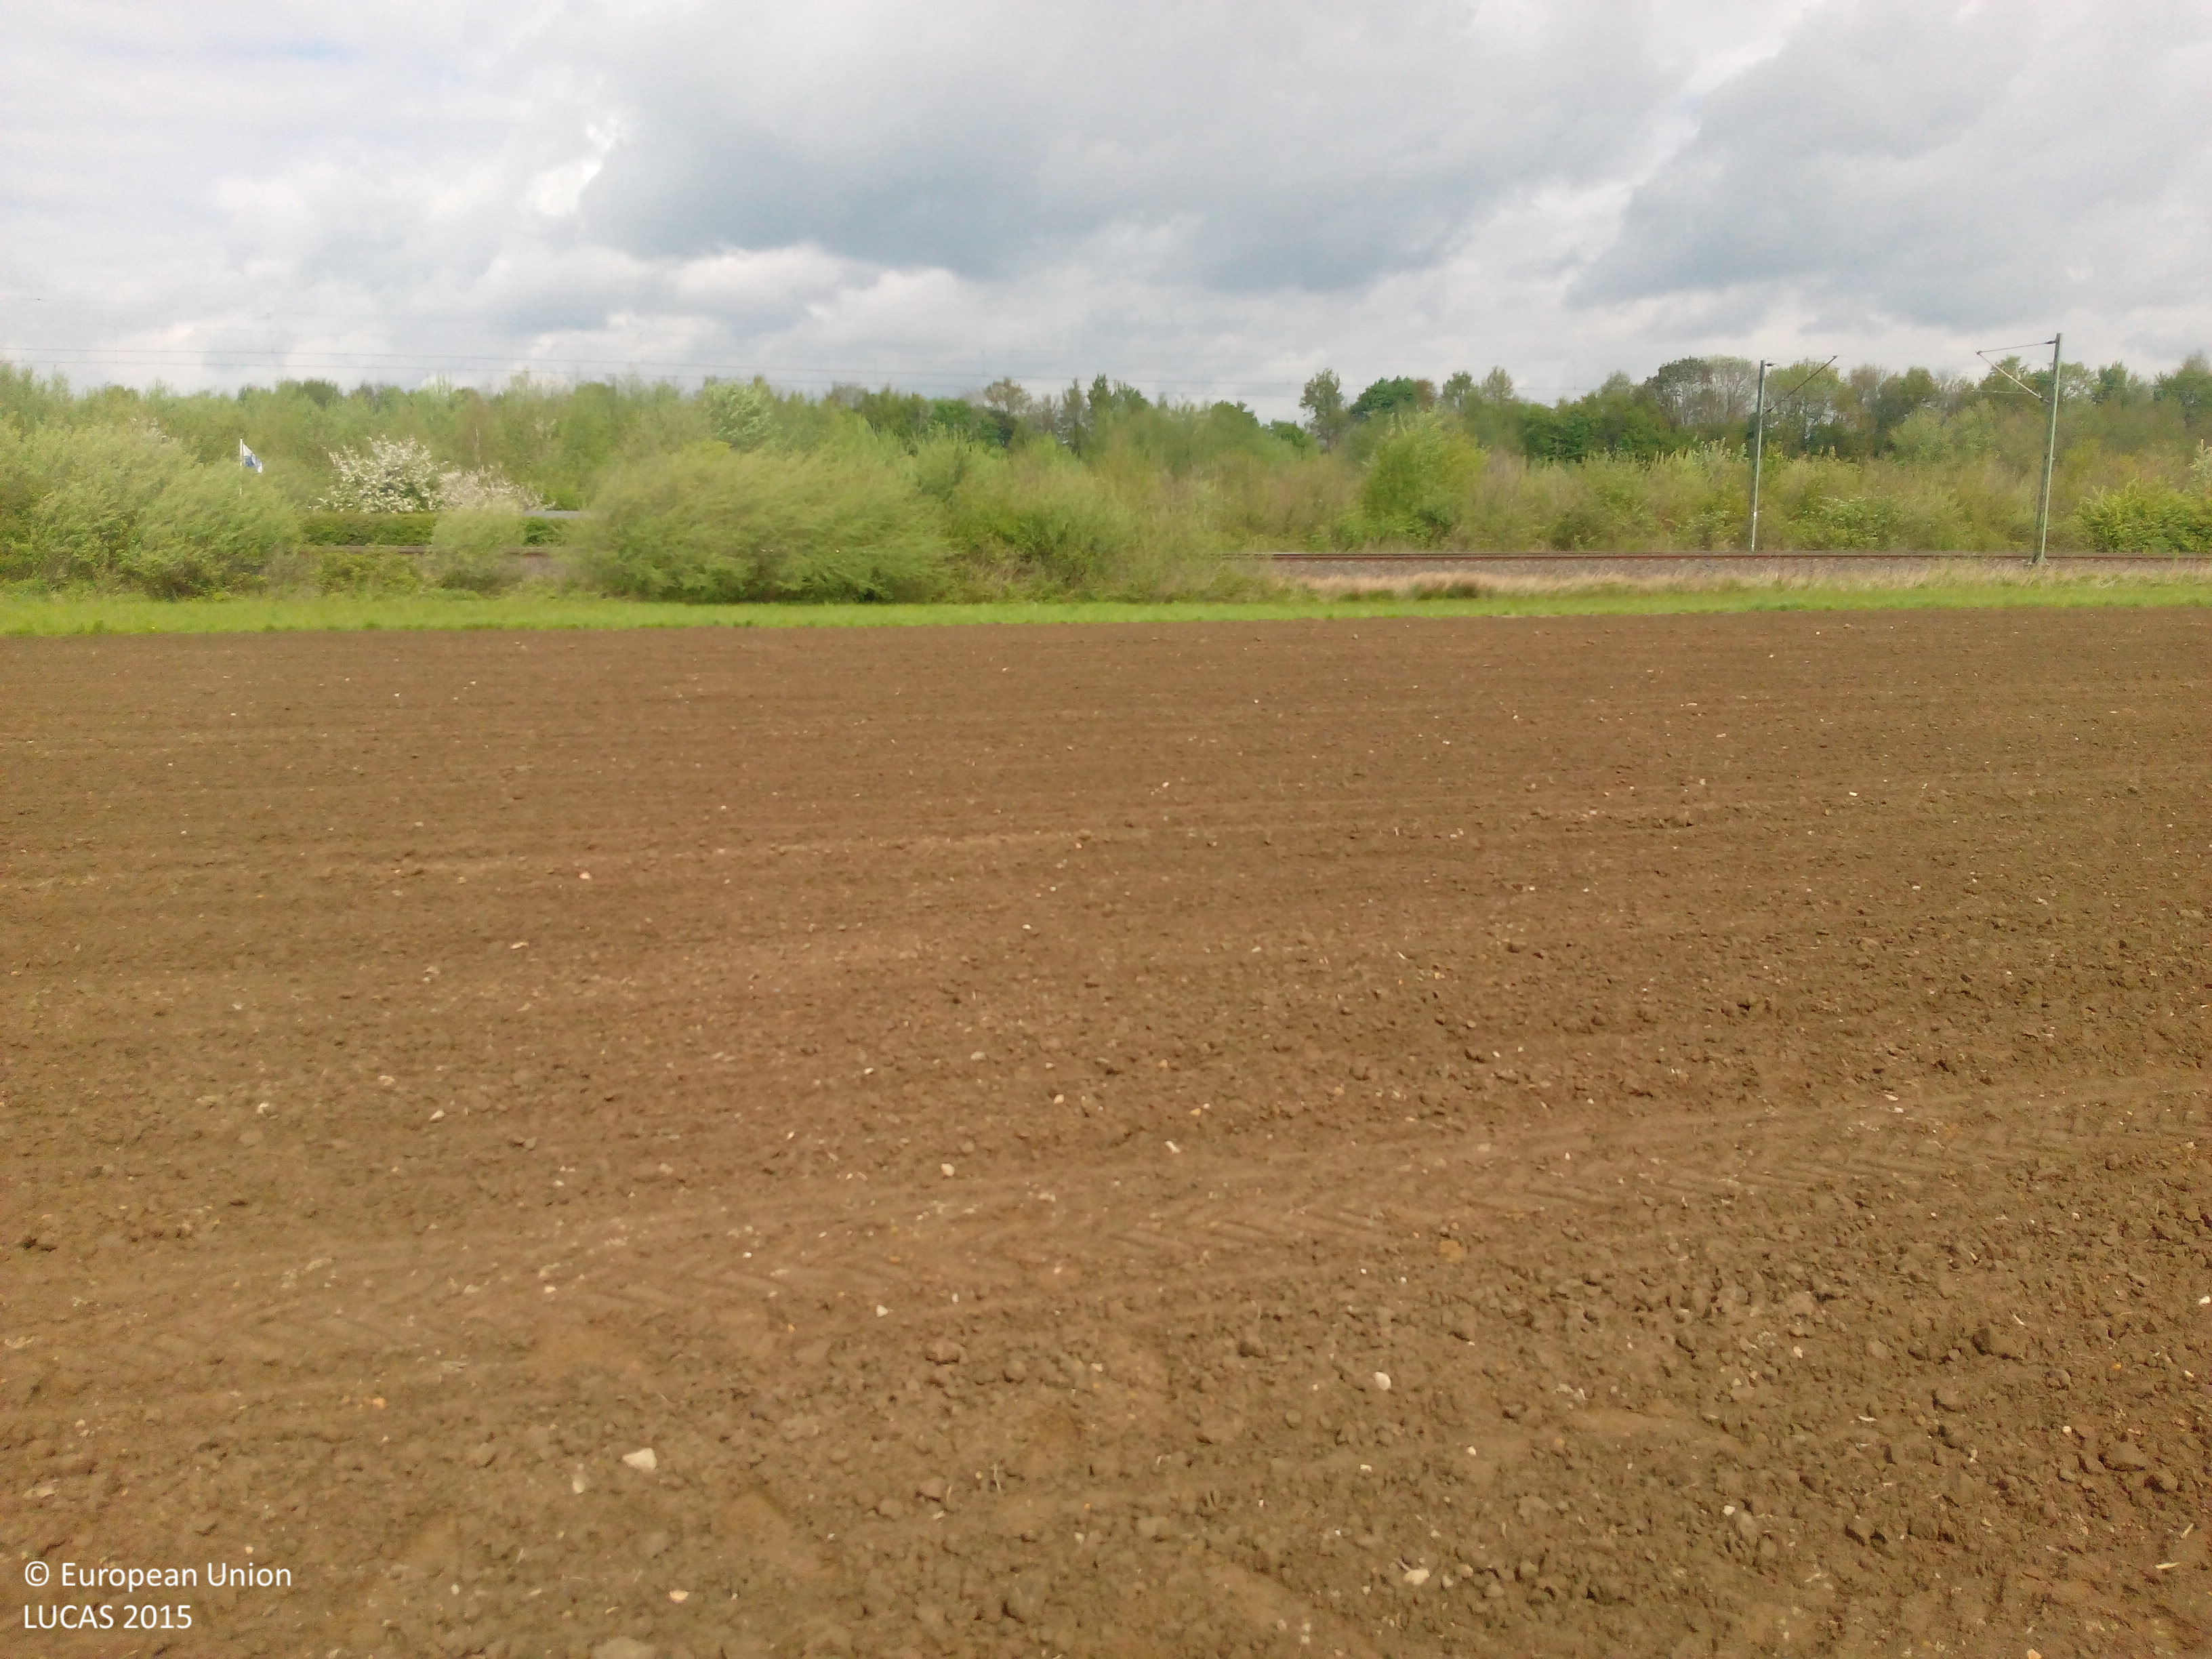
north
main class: Cropland
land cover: Maize
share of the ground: < 10 %
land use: Agriculture (excluding fallow land and kitchen gardens)
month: May
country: DE
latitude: 51.9007
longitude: 7.4569
